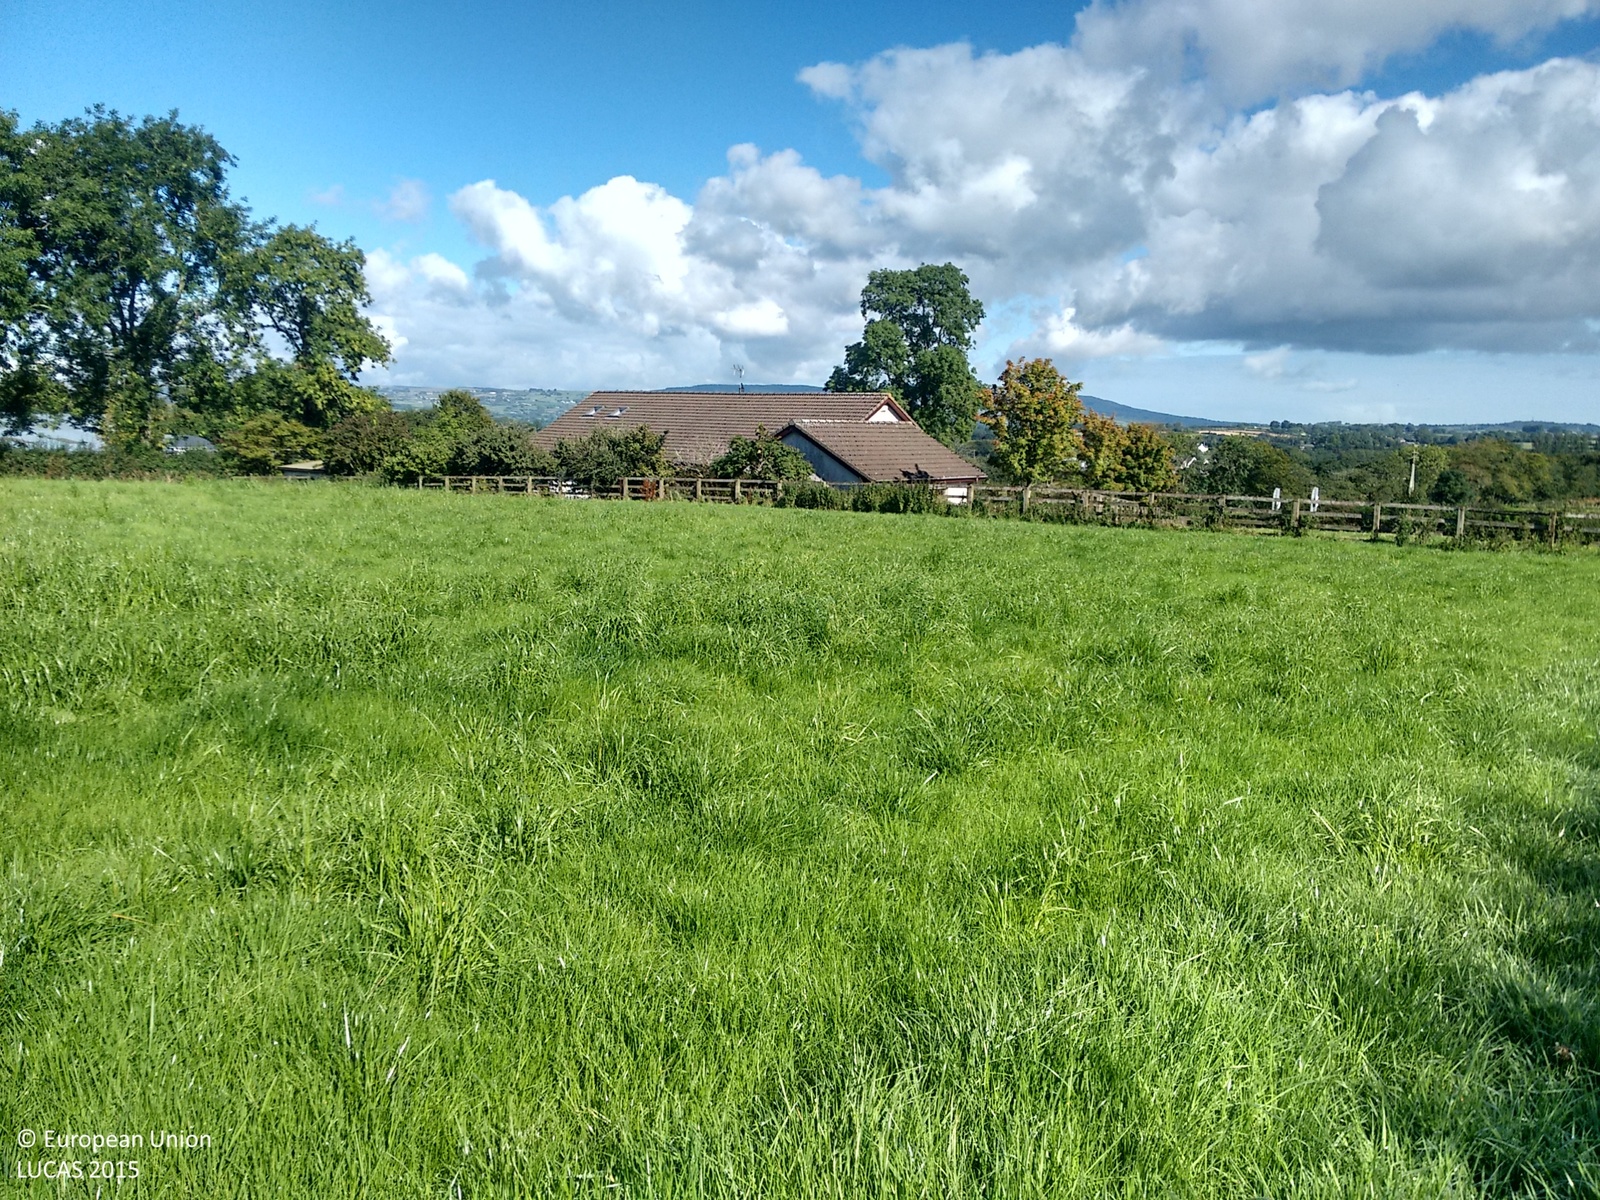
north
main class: Grassland
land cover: Grassland without tree/shrub cover
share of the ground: > 75 %
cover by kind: herbaceous plants 100 %
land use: Agriculture (excluding fallow land and kitchen gardens)
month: September
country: GB
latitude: 54.7374
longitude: -5.9660
